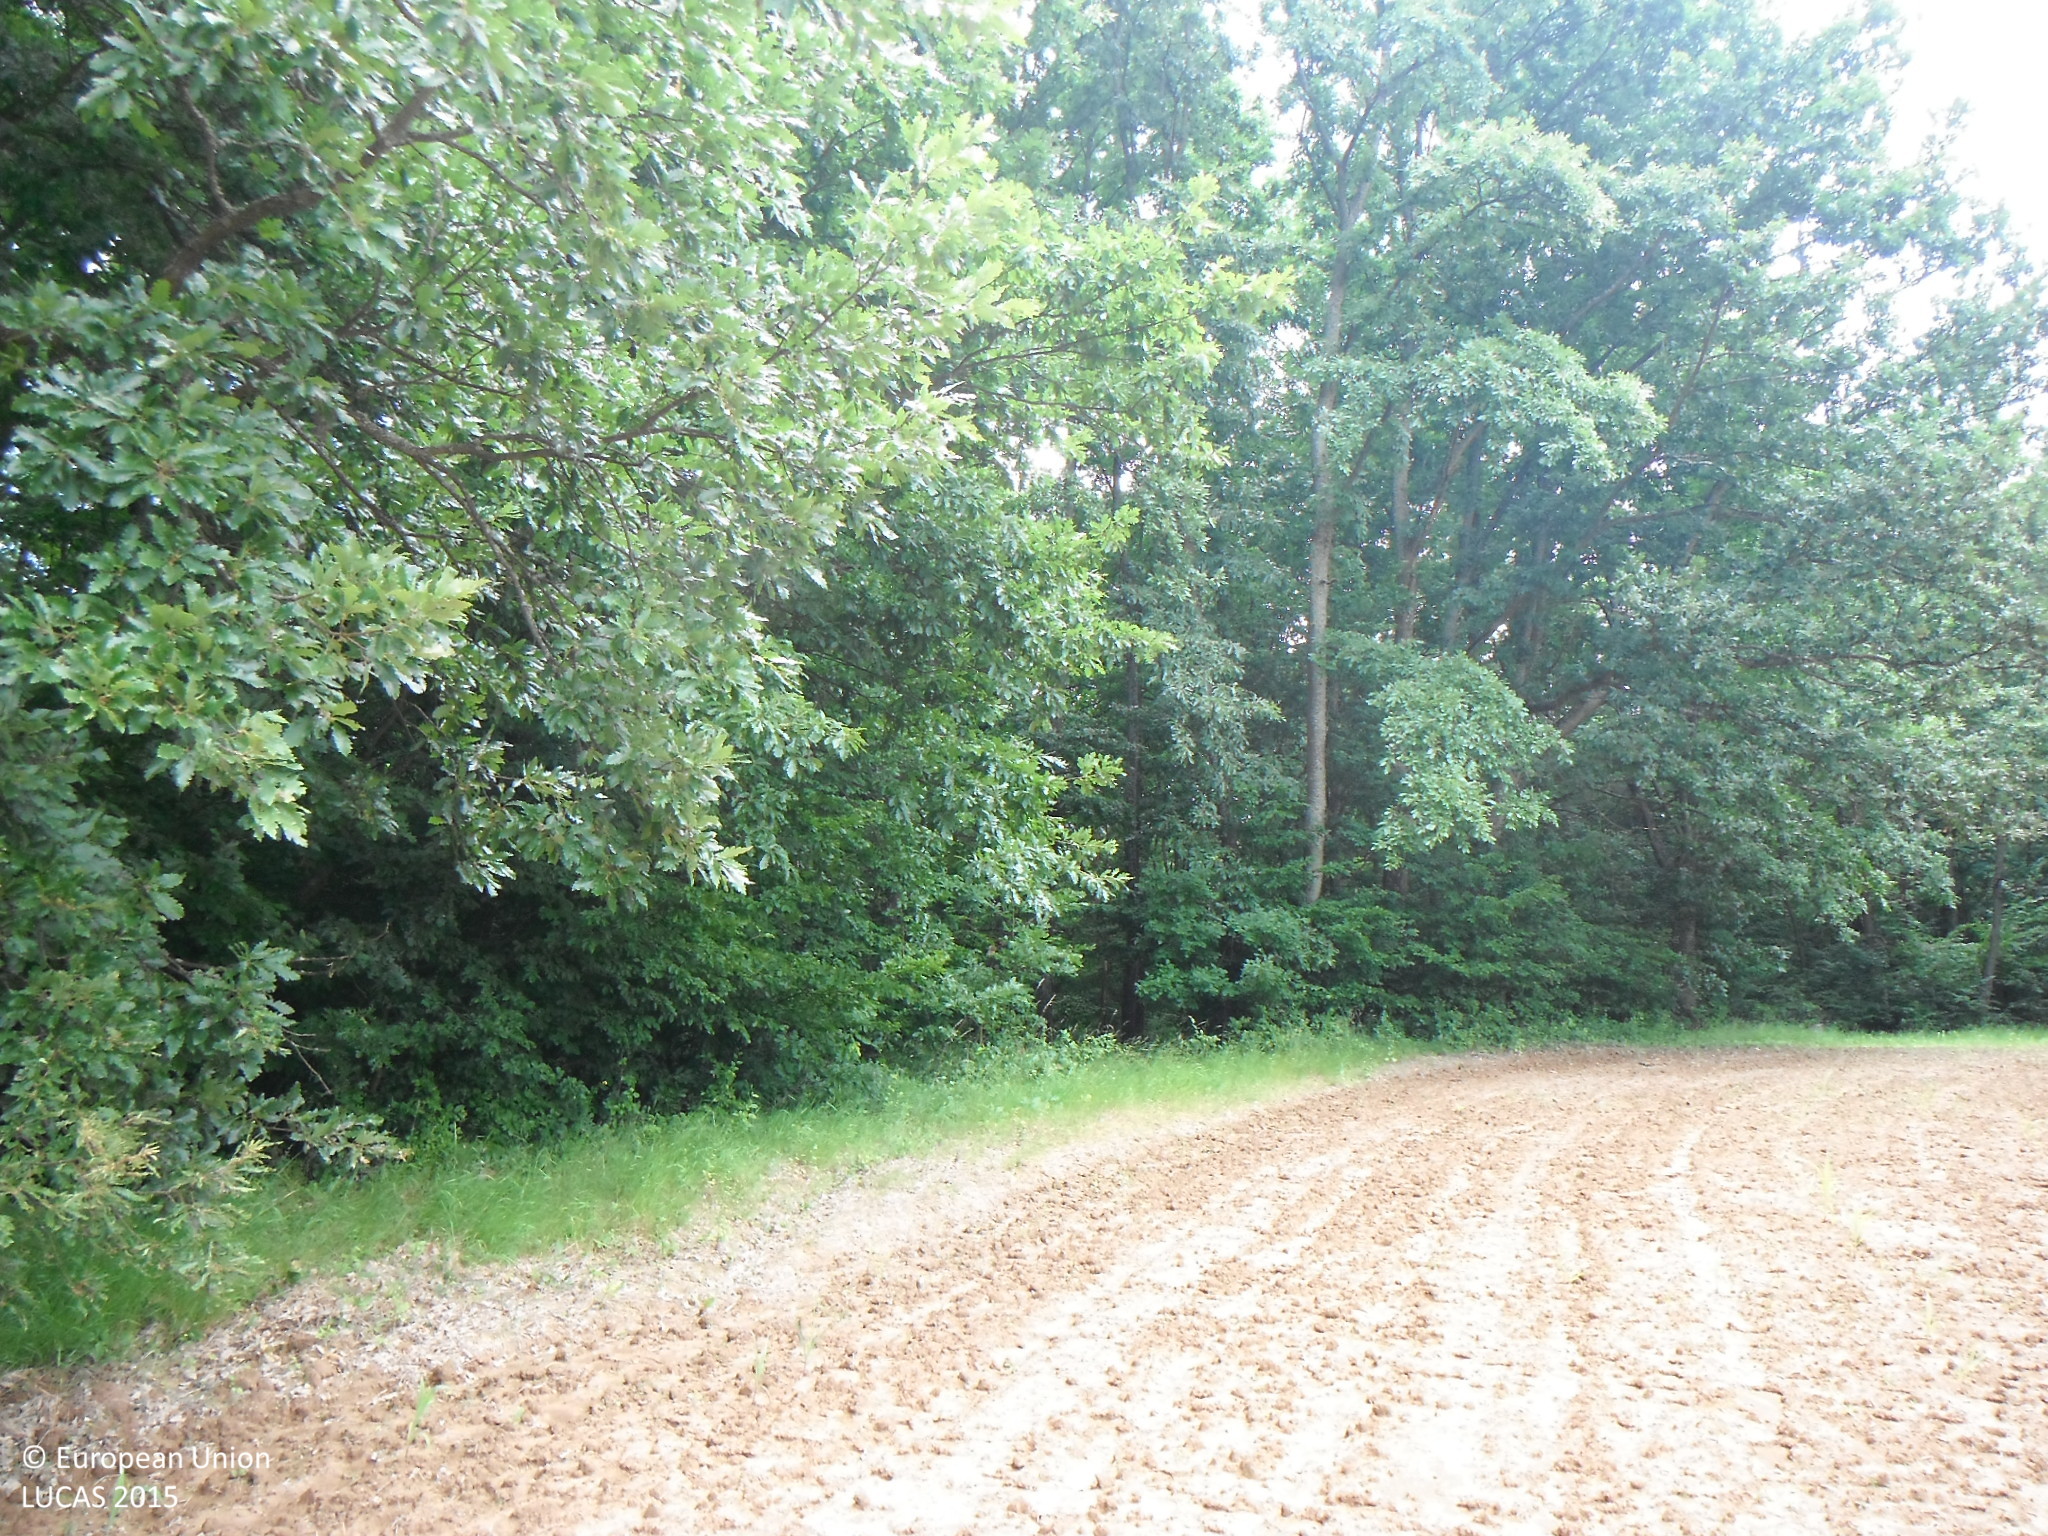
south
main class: Cropland
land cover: Maize
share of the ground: < 10 %
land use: Agriculture (excluding fallow land and kitchen gardens)
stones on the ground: < 10 %
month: June
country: SK
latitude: 48.4644
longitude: 19.9148
